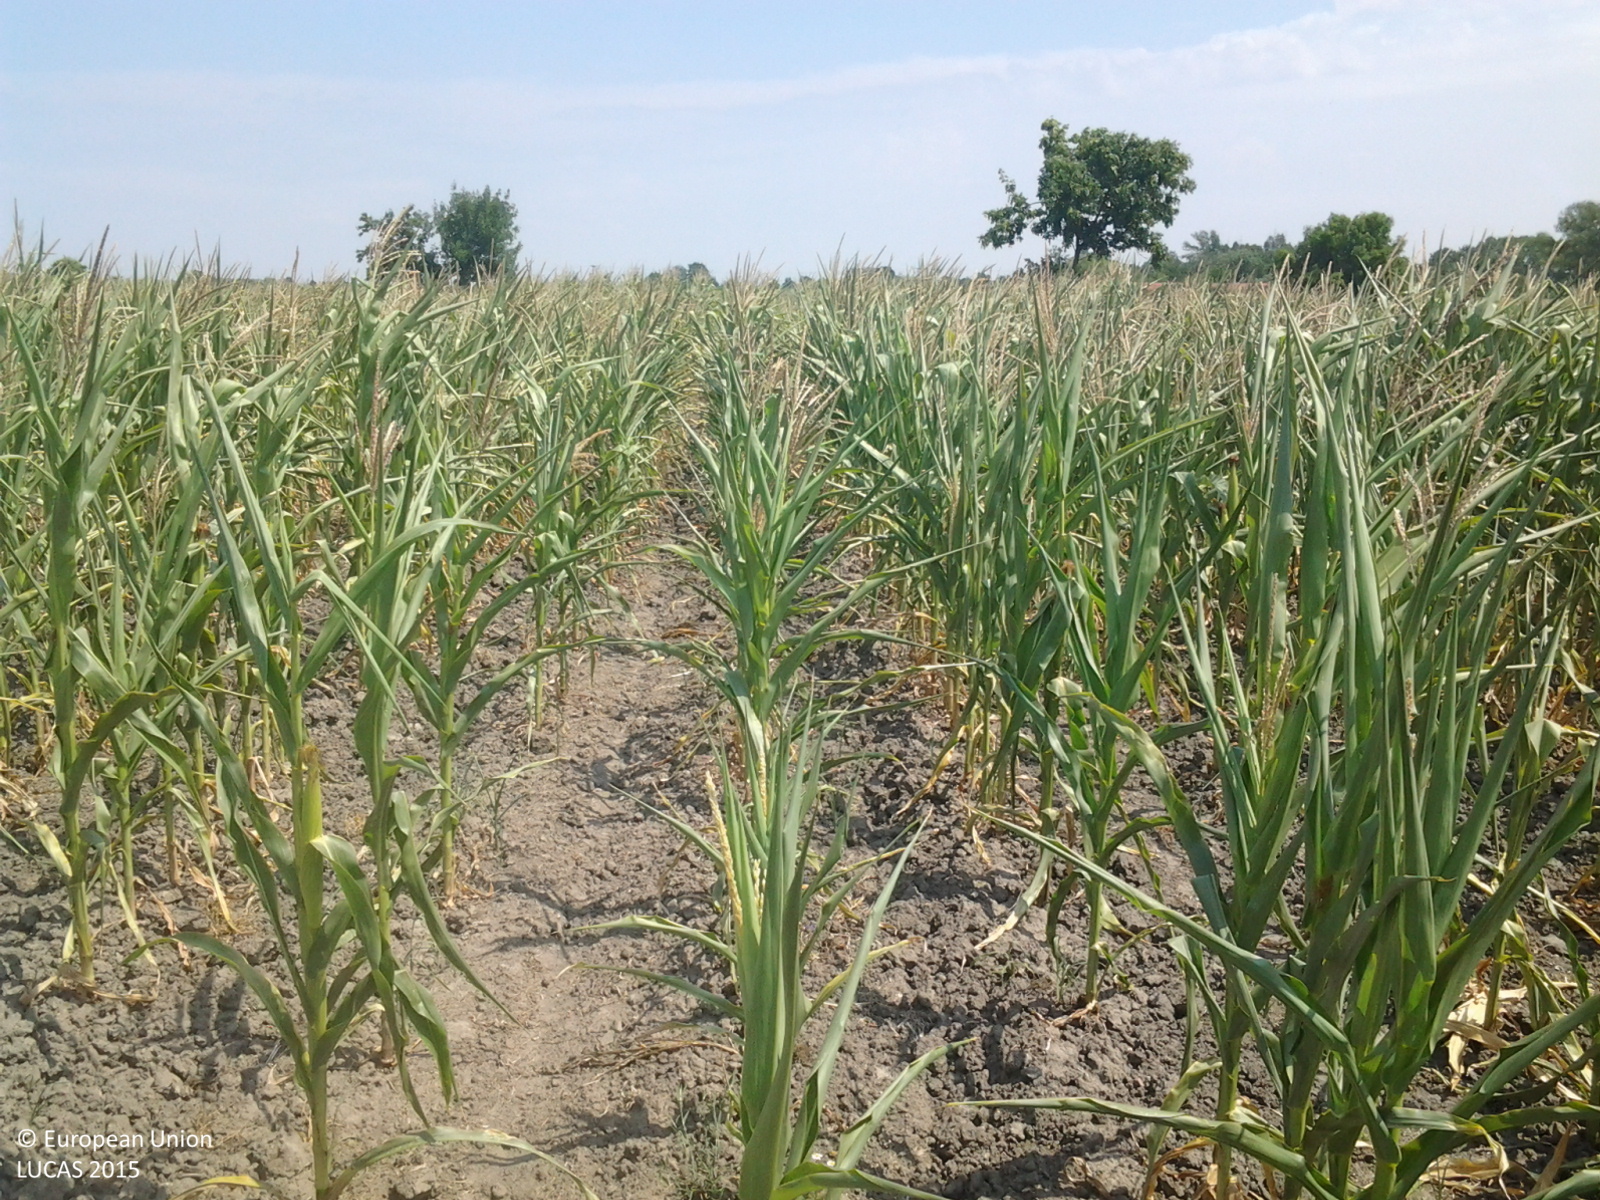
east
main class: Cropland
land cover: Maize
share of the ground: > 75 %
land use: Agriculture (excluding fallow land and kitchen gardens)
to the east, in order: Maize; Grass margins; Ditches and canals; Grass margins; Tracks; Grass margins; Common wheat
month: July
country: HU
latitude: 46.8216
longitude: 21.4822
